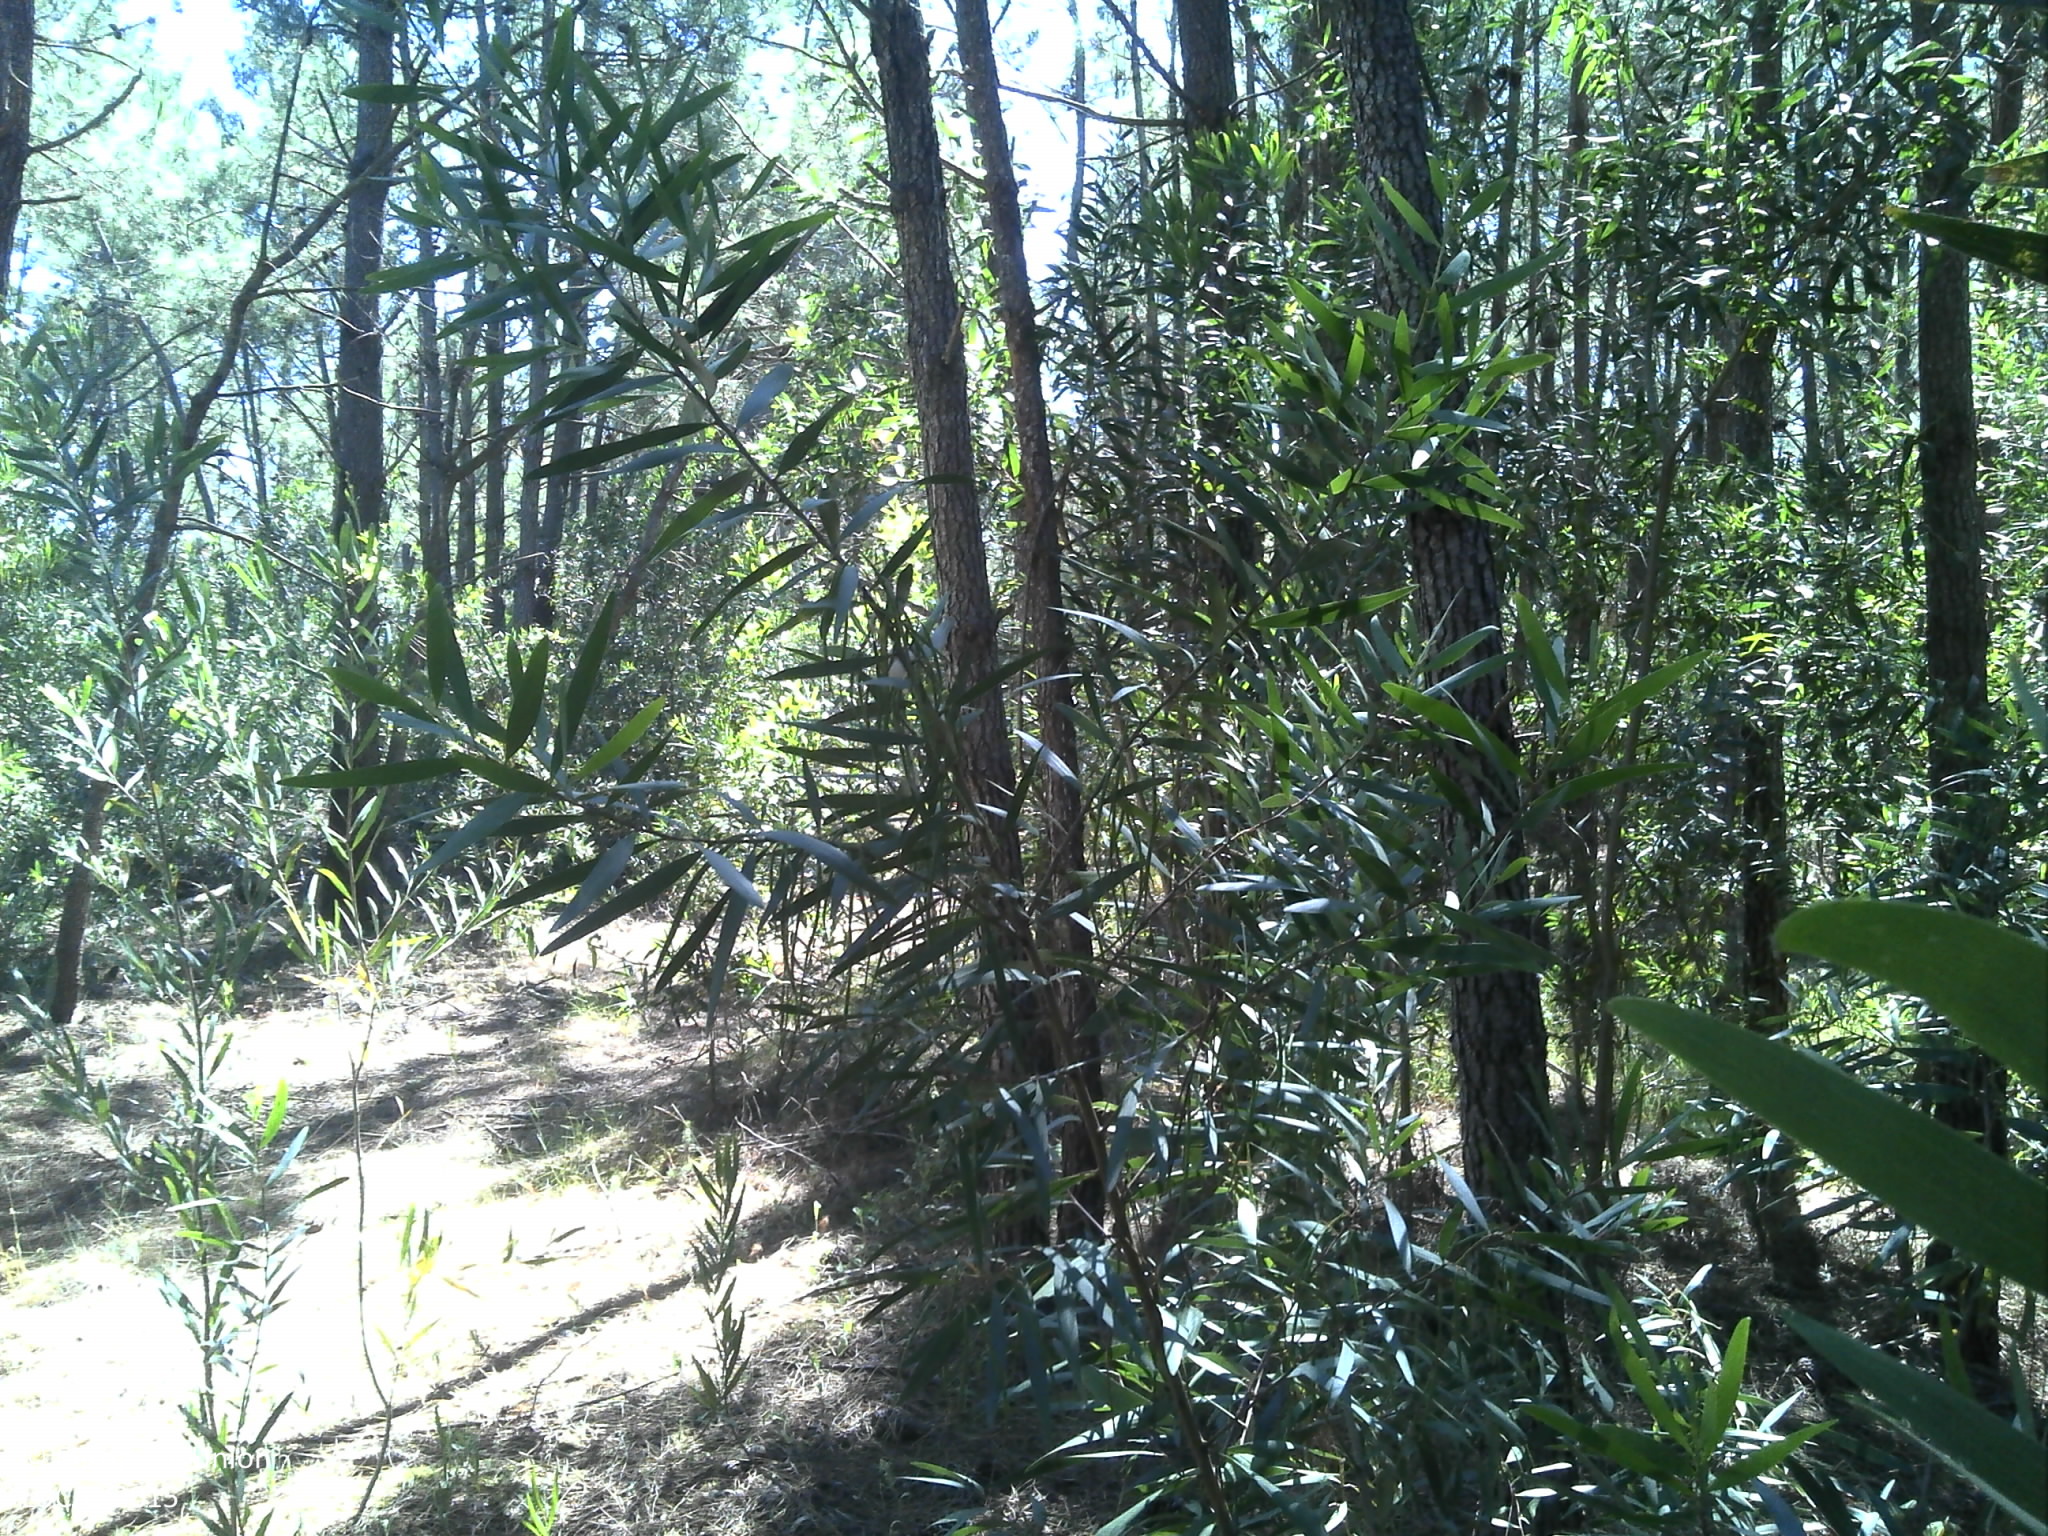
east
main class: Woodland
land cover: Pine dominated coniferous woodland
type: coniferous forest of the mediterranean region
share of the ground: 50 - 75 %
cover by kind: coniferous forest trees 65 %, shrubs 20 %, unconsolidated bare surface 15 %
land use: Forestry
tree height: > 5 m
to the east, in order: Pine dominated coniferous woodland; Tracks; Pine dominated coniferous woodland; Tracks; Pine dominated coniferous woodland; Shrubland with sparse tree cover; Pine dominated coniferous woodland
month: May
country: PT
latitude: 40.5129
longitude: -8.7574
